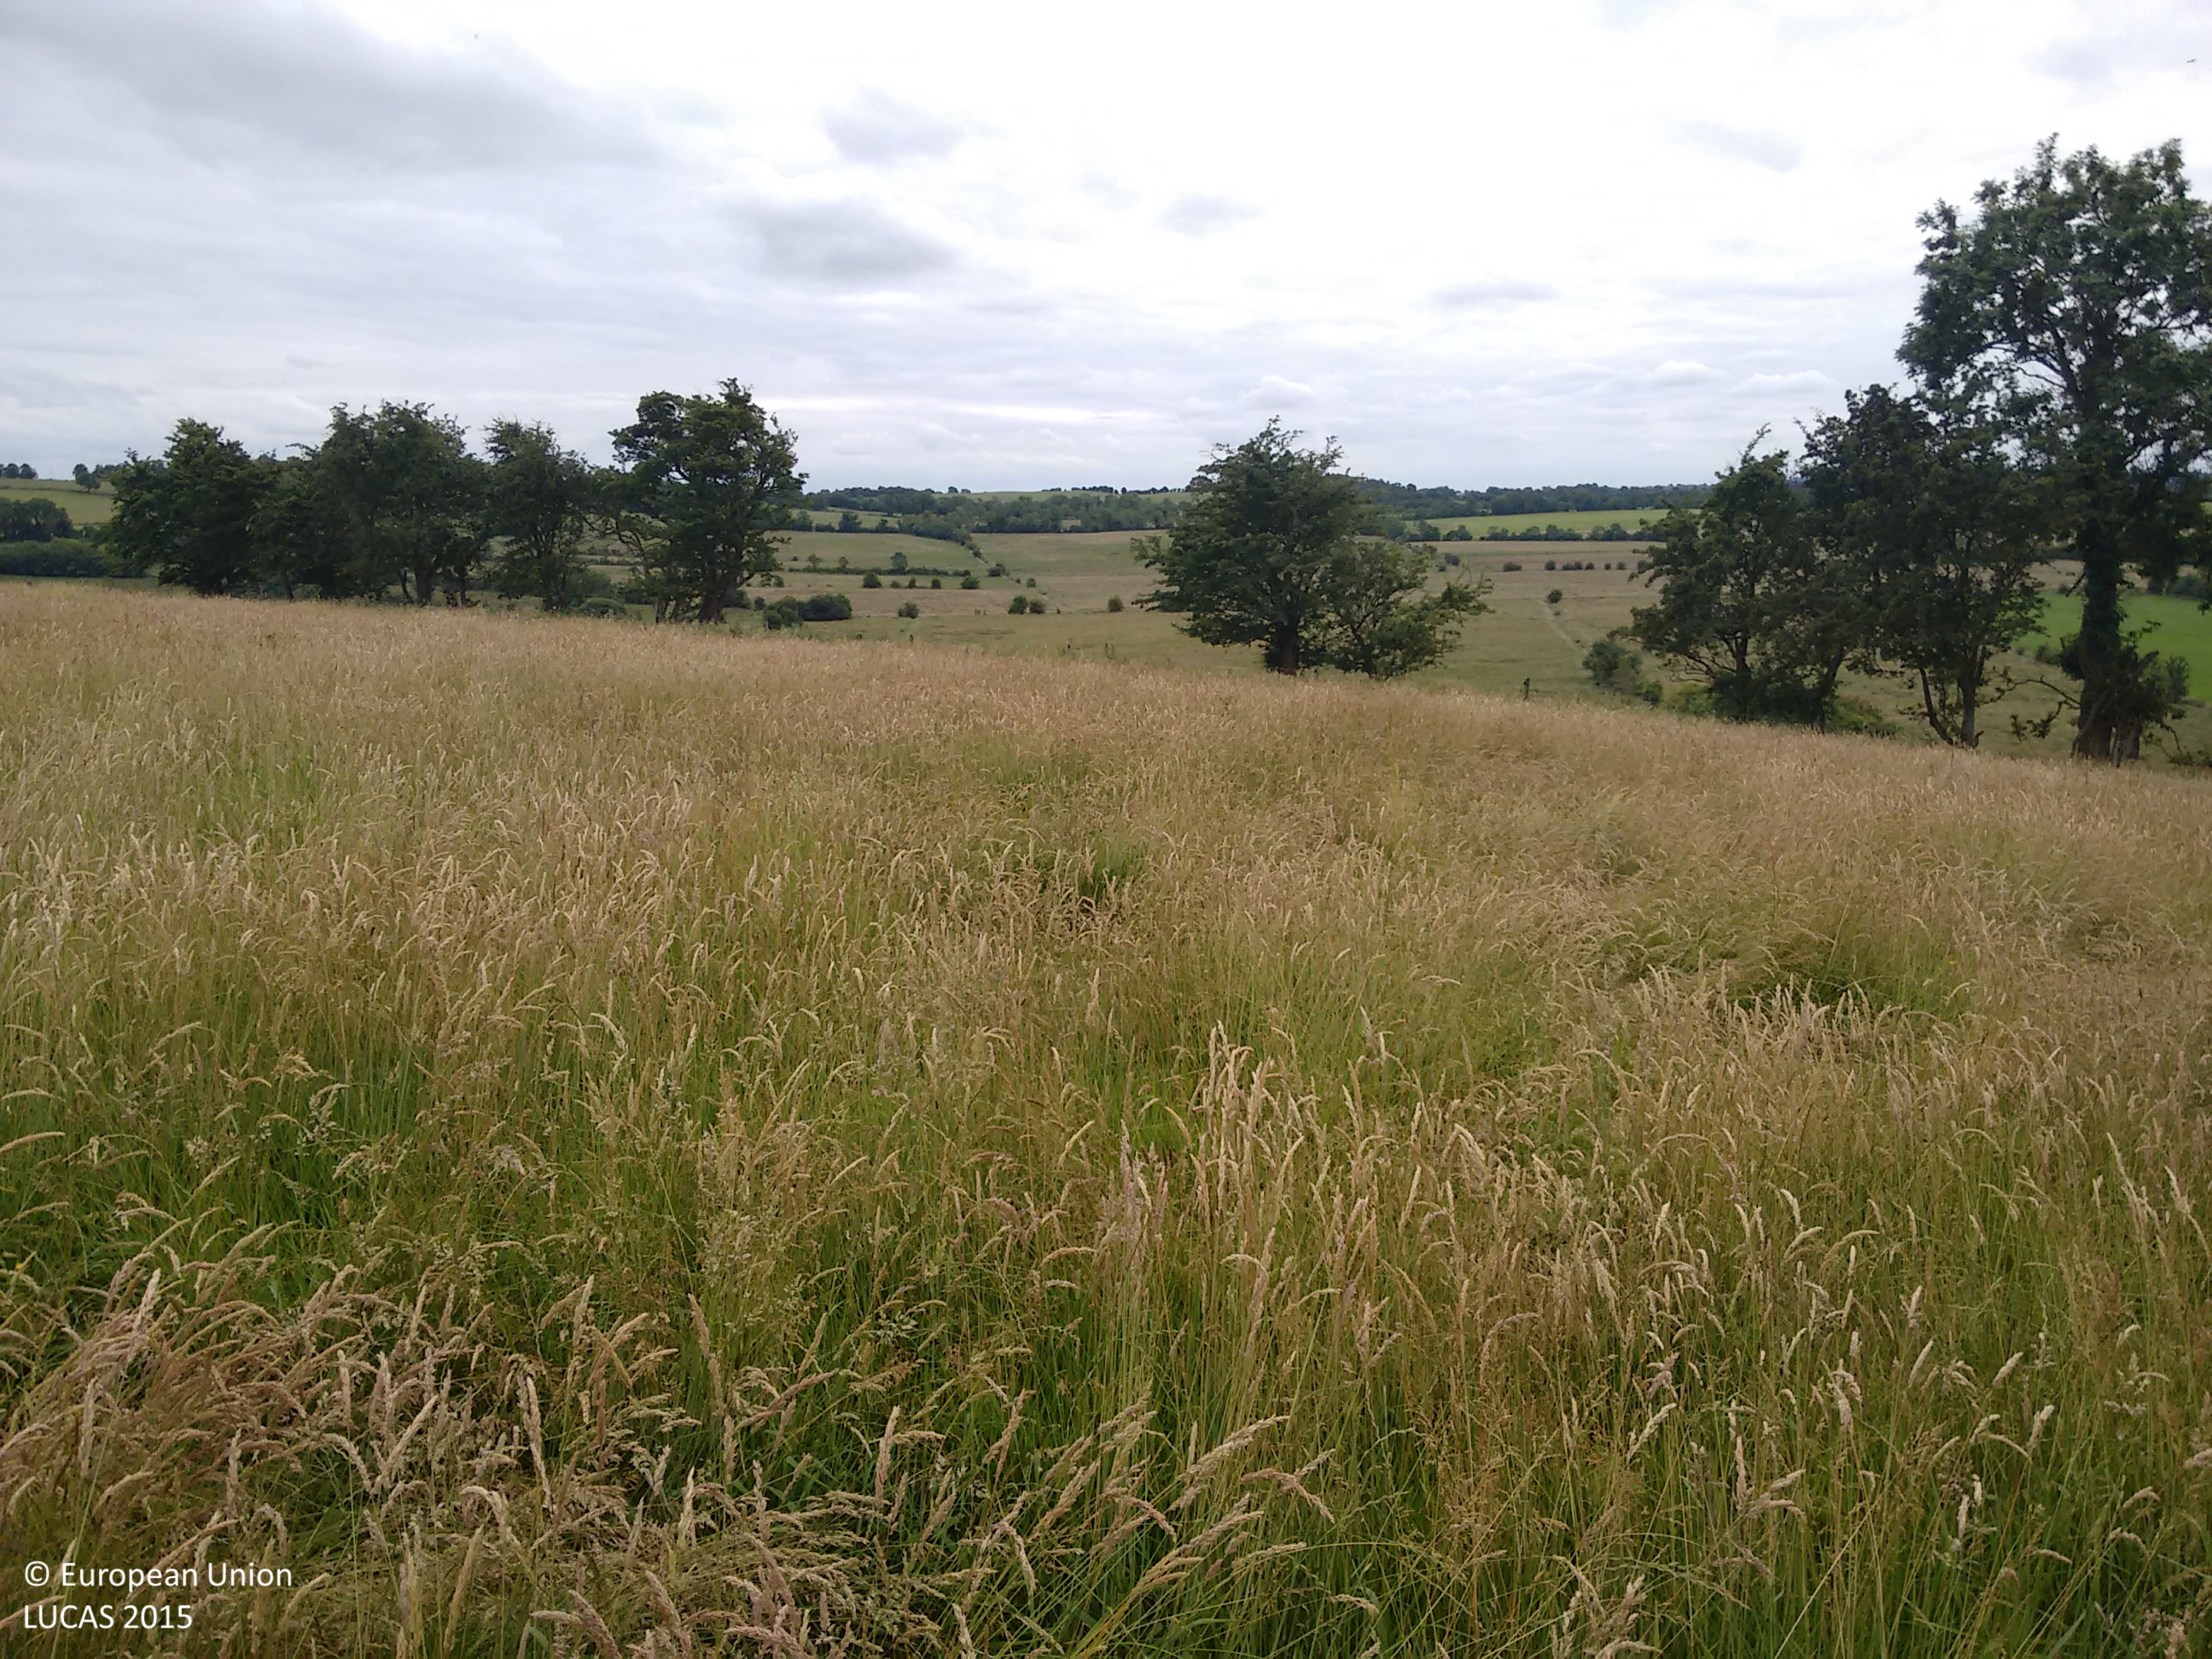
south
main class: Grassland
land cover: Grassland without tree/shrub cover
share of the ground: > 75 %
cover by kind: herbaceous plants 100 %
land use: Agriculture (excluding fallow land and kitchen gardens)
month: July
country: IE
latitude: 53.4678
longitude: -7.6837
